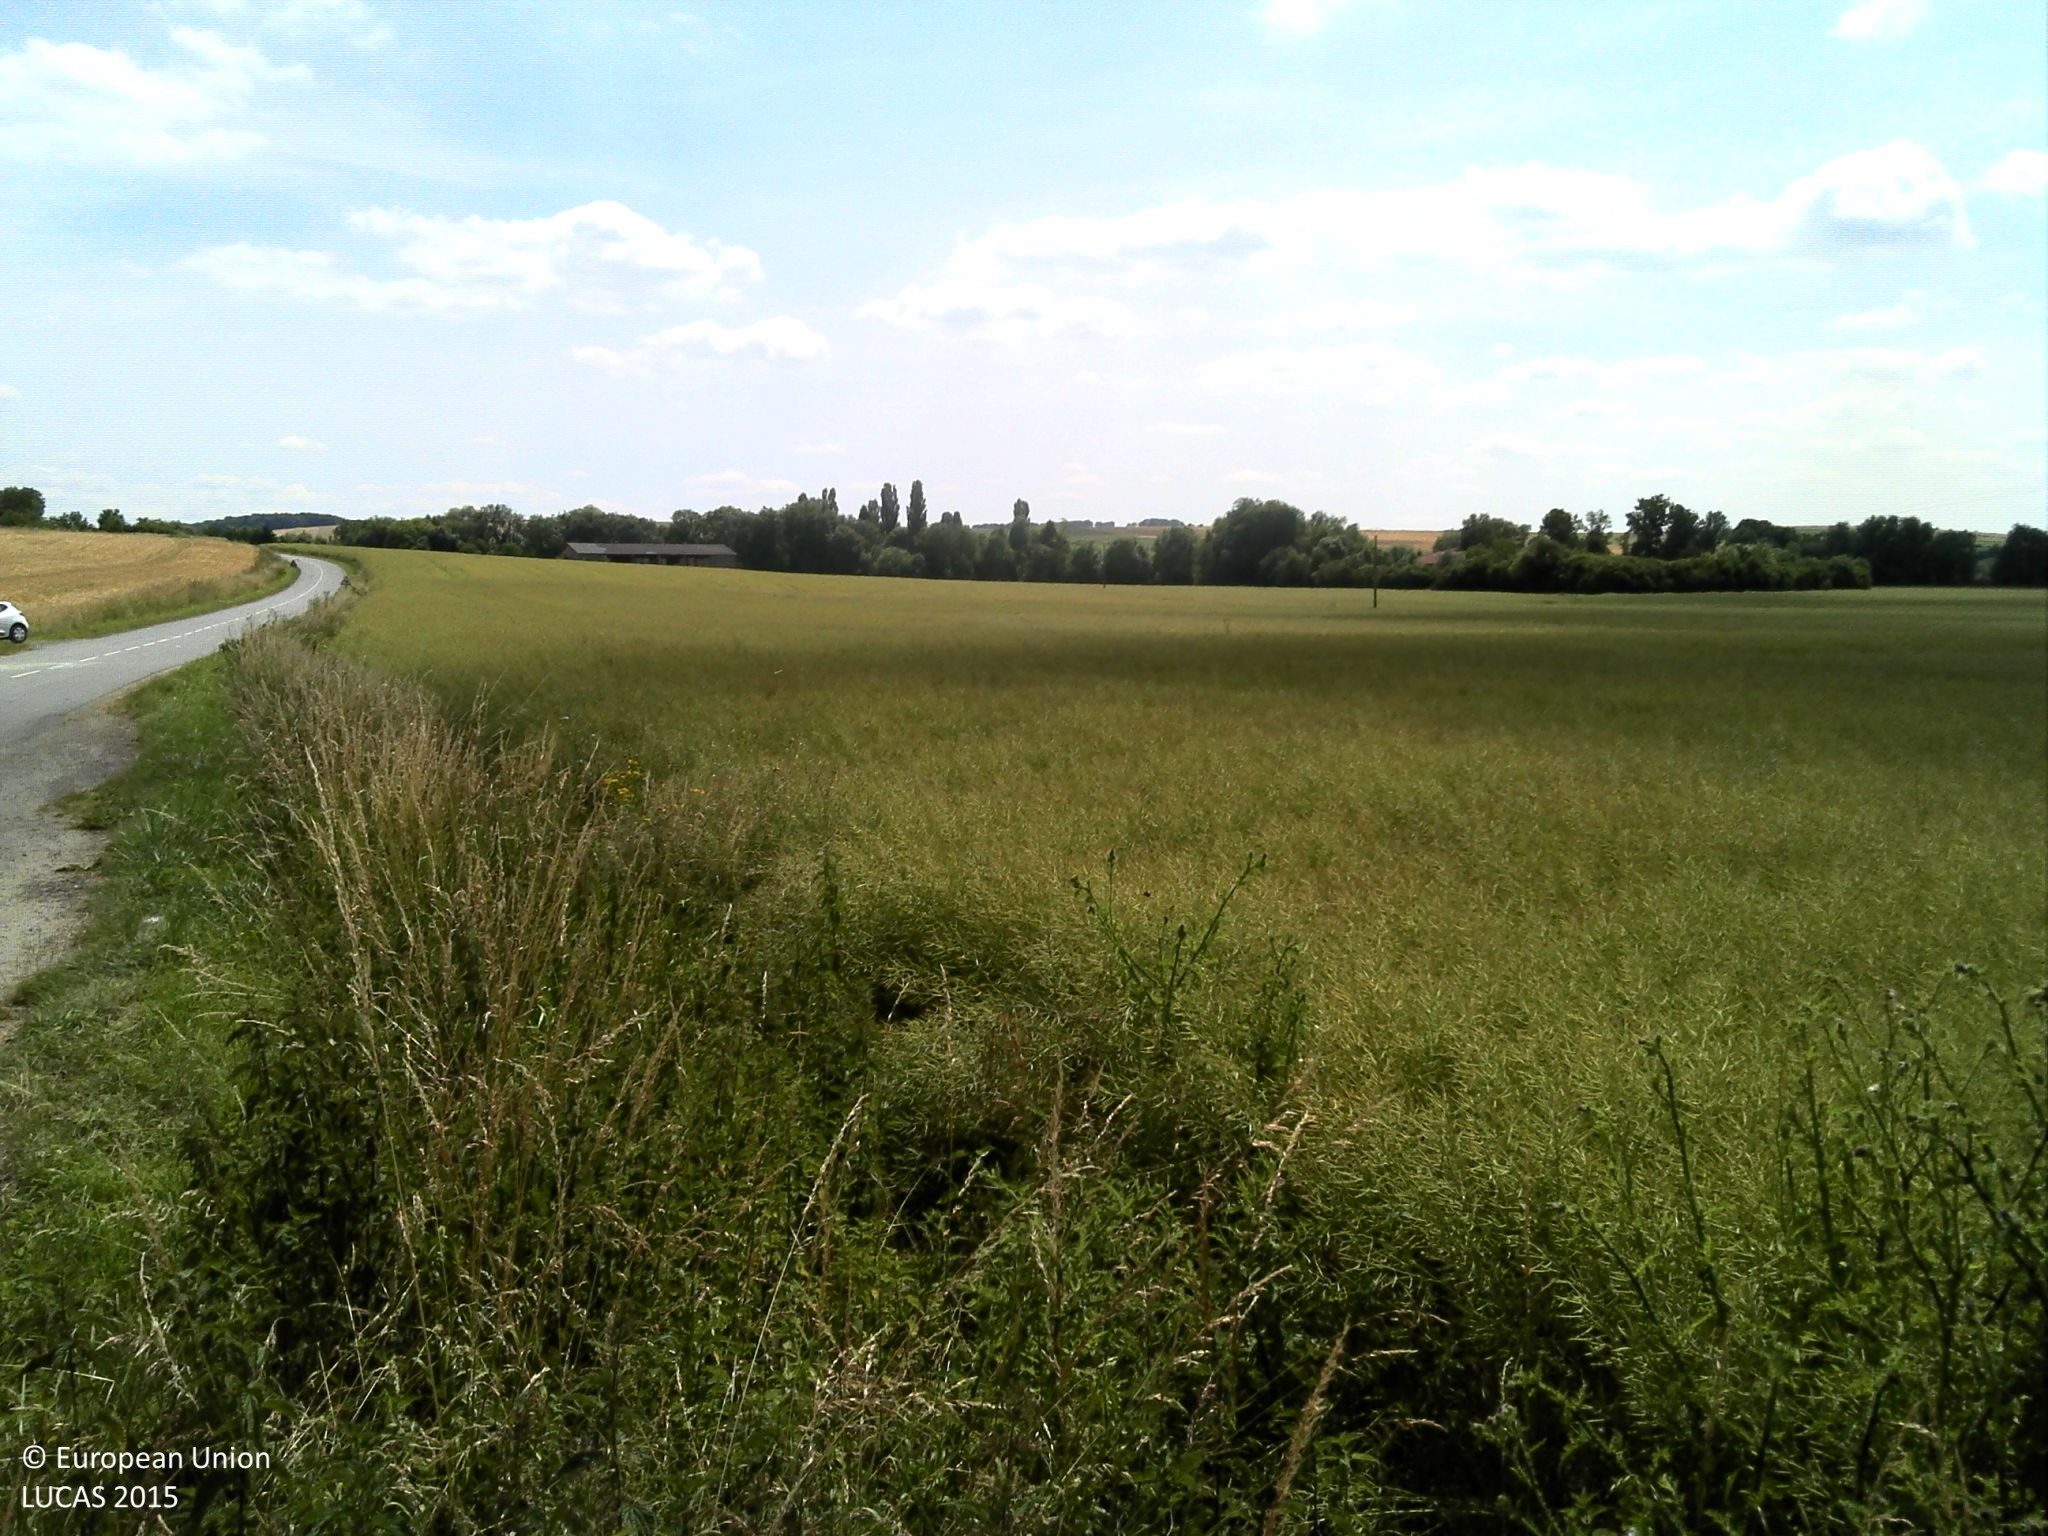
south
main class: Cropland
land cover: Rape and turnip rape
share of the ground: > 75 %
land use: Agriculture (excluding fallow land and kitchen gardens)
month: June
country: FR
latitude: 49.1389
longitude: 6.4498
